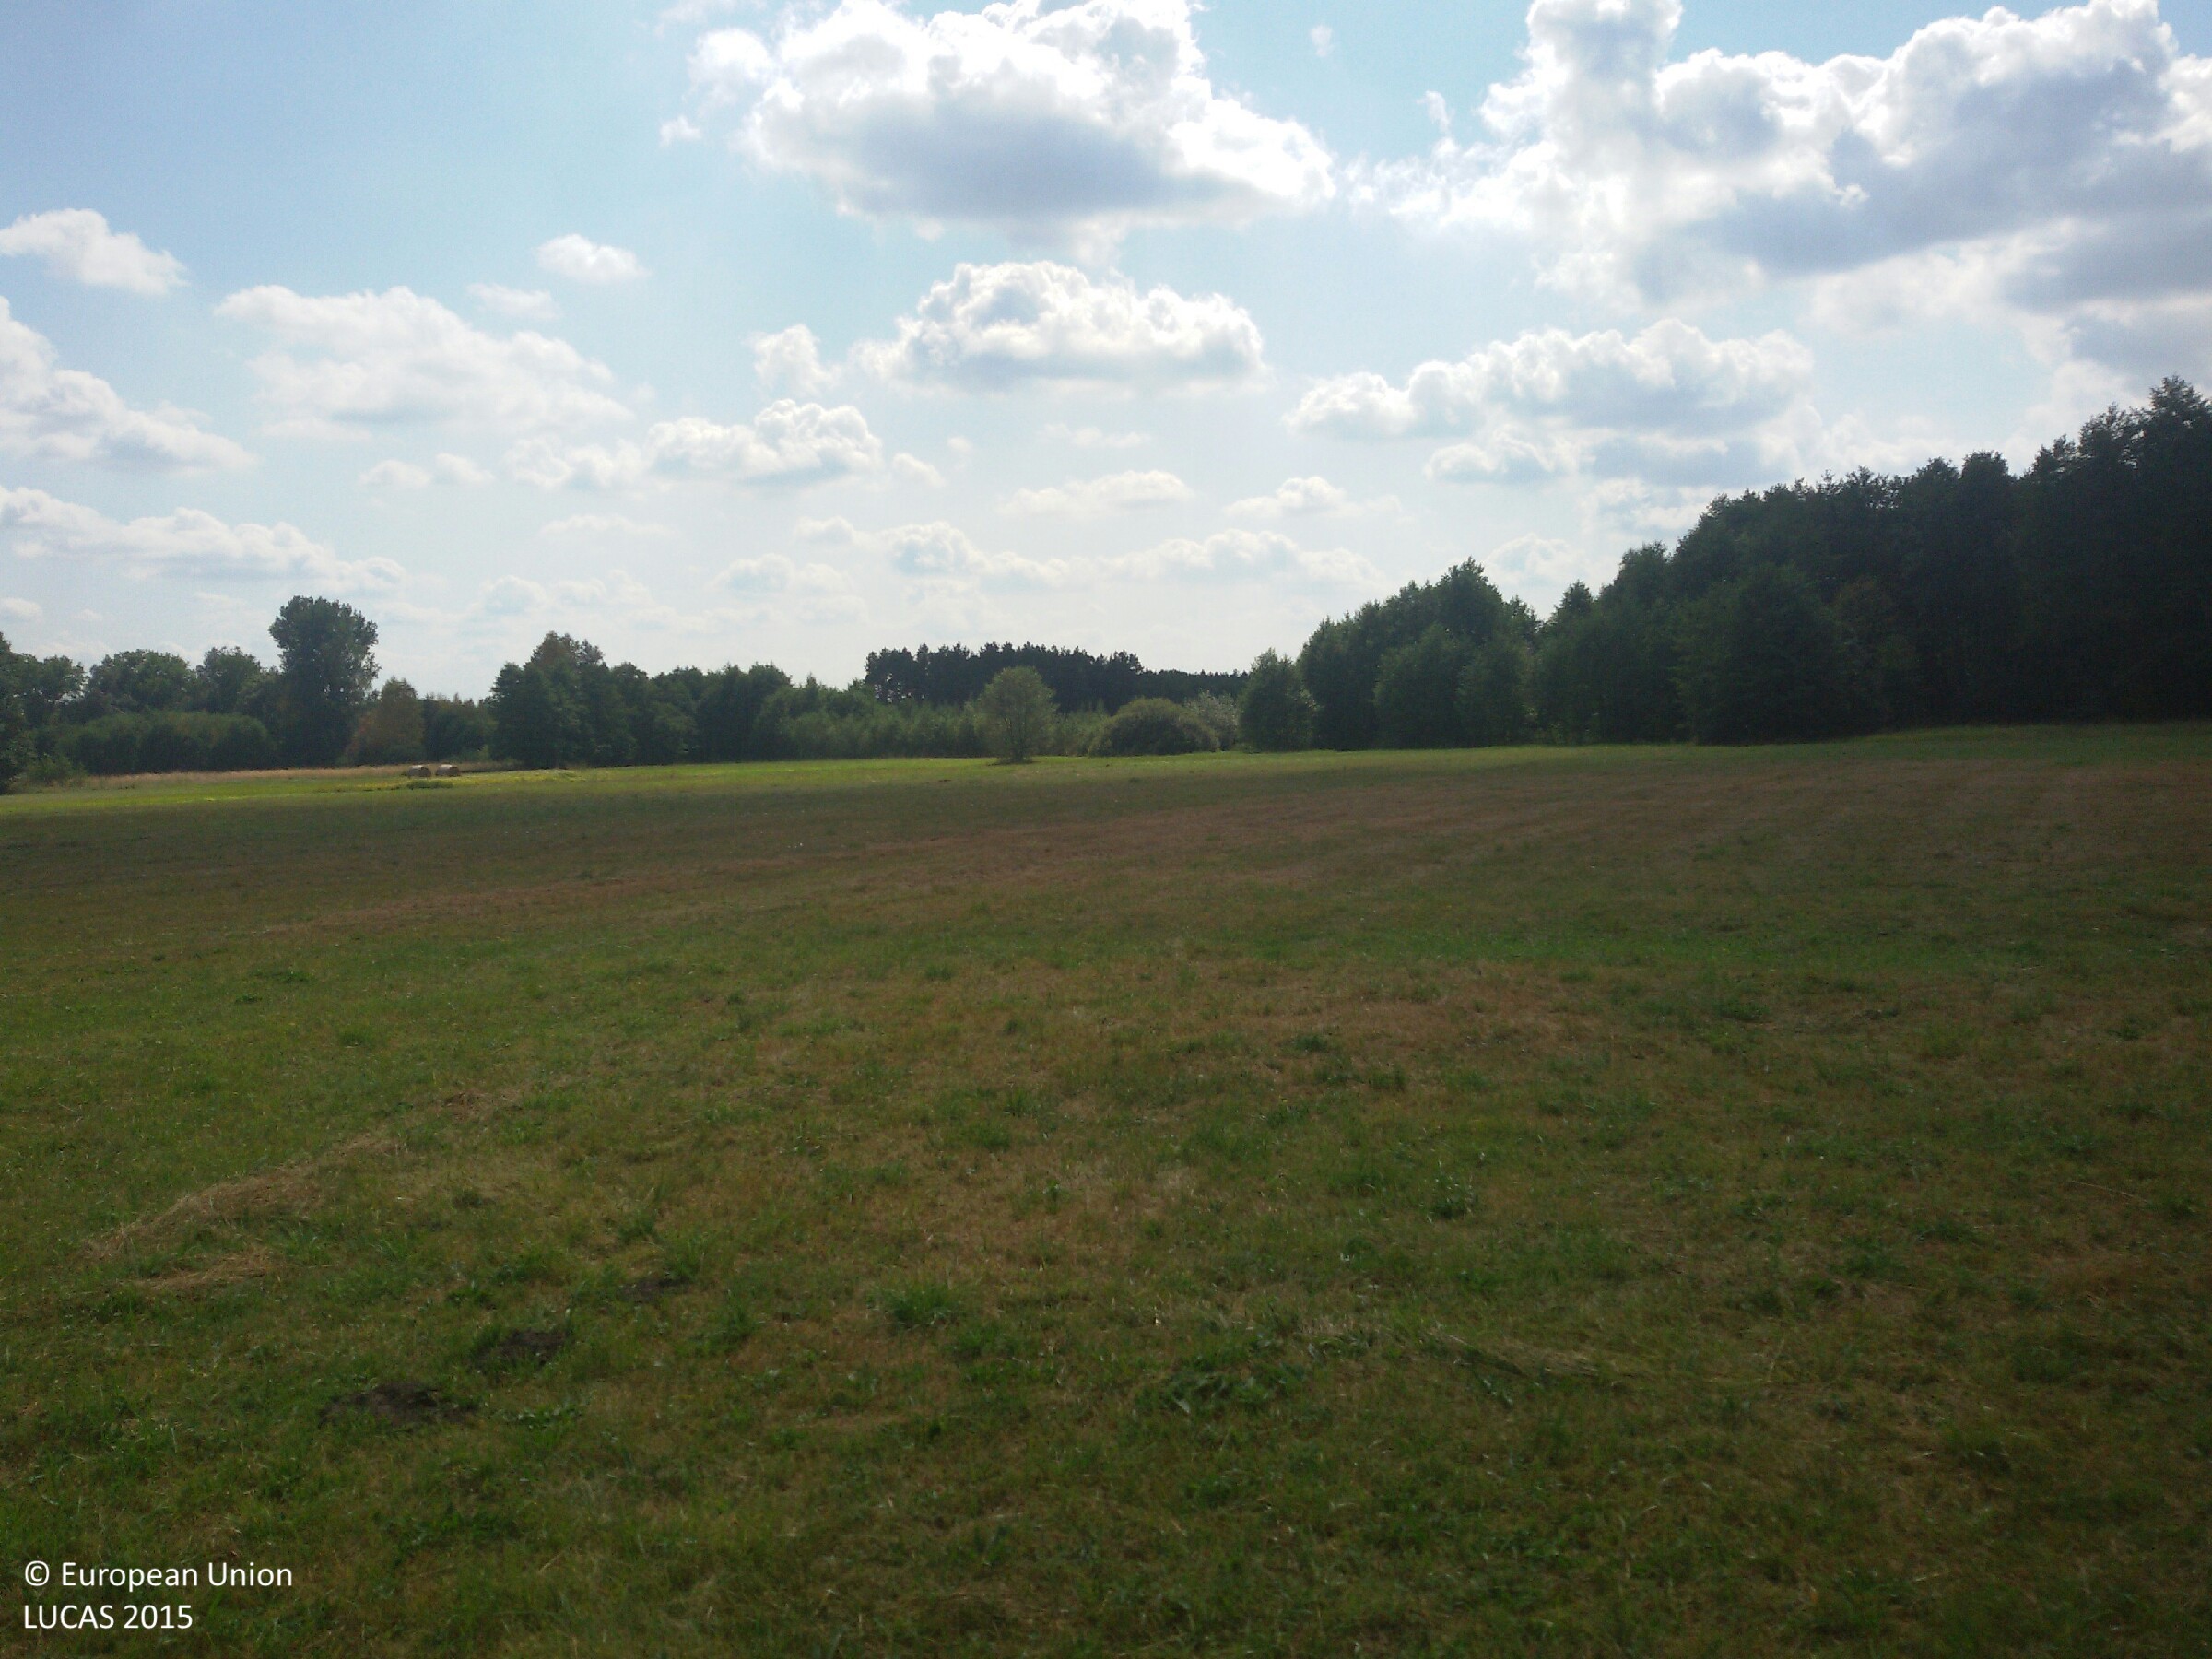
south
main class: Grassland
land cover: Grassland without tree/shrub cover
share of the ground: > 75 %
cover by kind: herbaceous plants 100 %
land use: Agriculture (excluding fallow land and kitchen gardens)
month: August
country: PL
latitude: 50.5629
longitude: 20.7560
